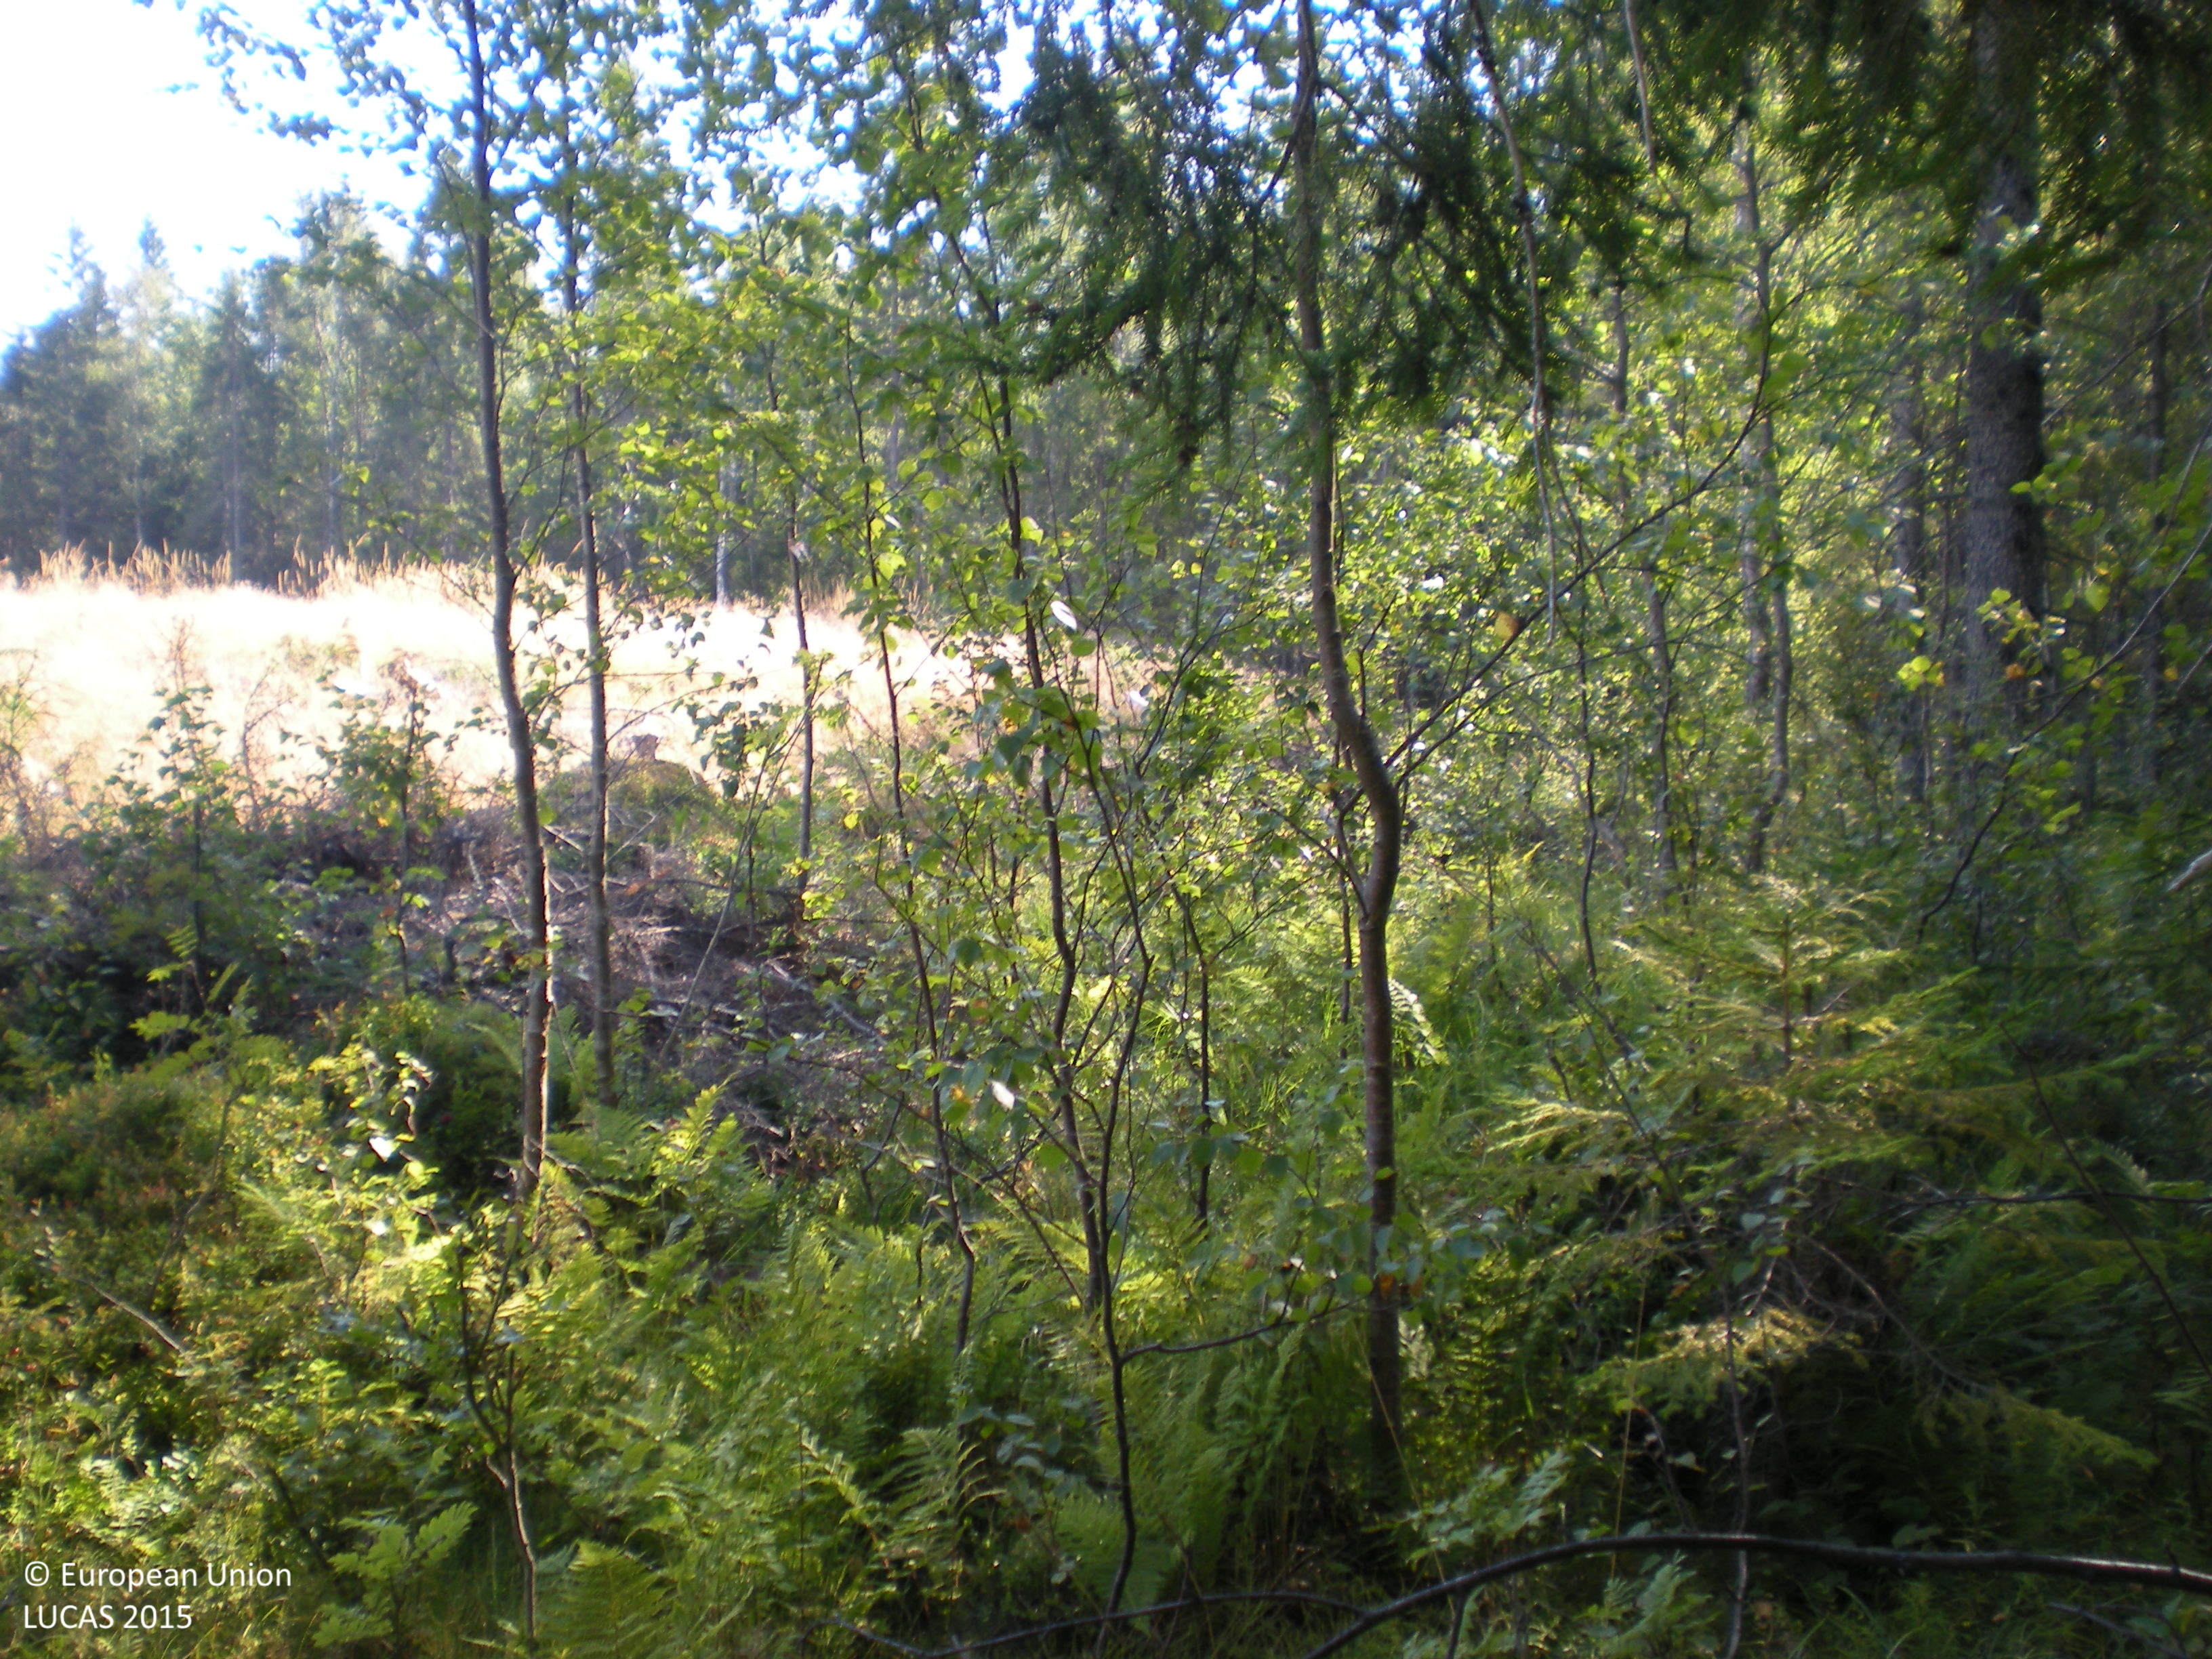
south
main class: Woodland
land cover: Other mixed woodland
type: boreal forest
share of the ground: 50 - 75 %
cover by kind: coniferous forest trees 50 %, broadleaved forest trees 20 %, shrubs 20 %, herbaceous plants 5 %, lichens and mosses 5 %
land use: Forestry
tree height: > 5 m
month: August
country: SE
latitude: 60.5899
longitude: 17.2739
